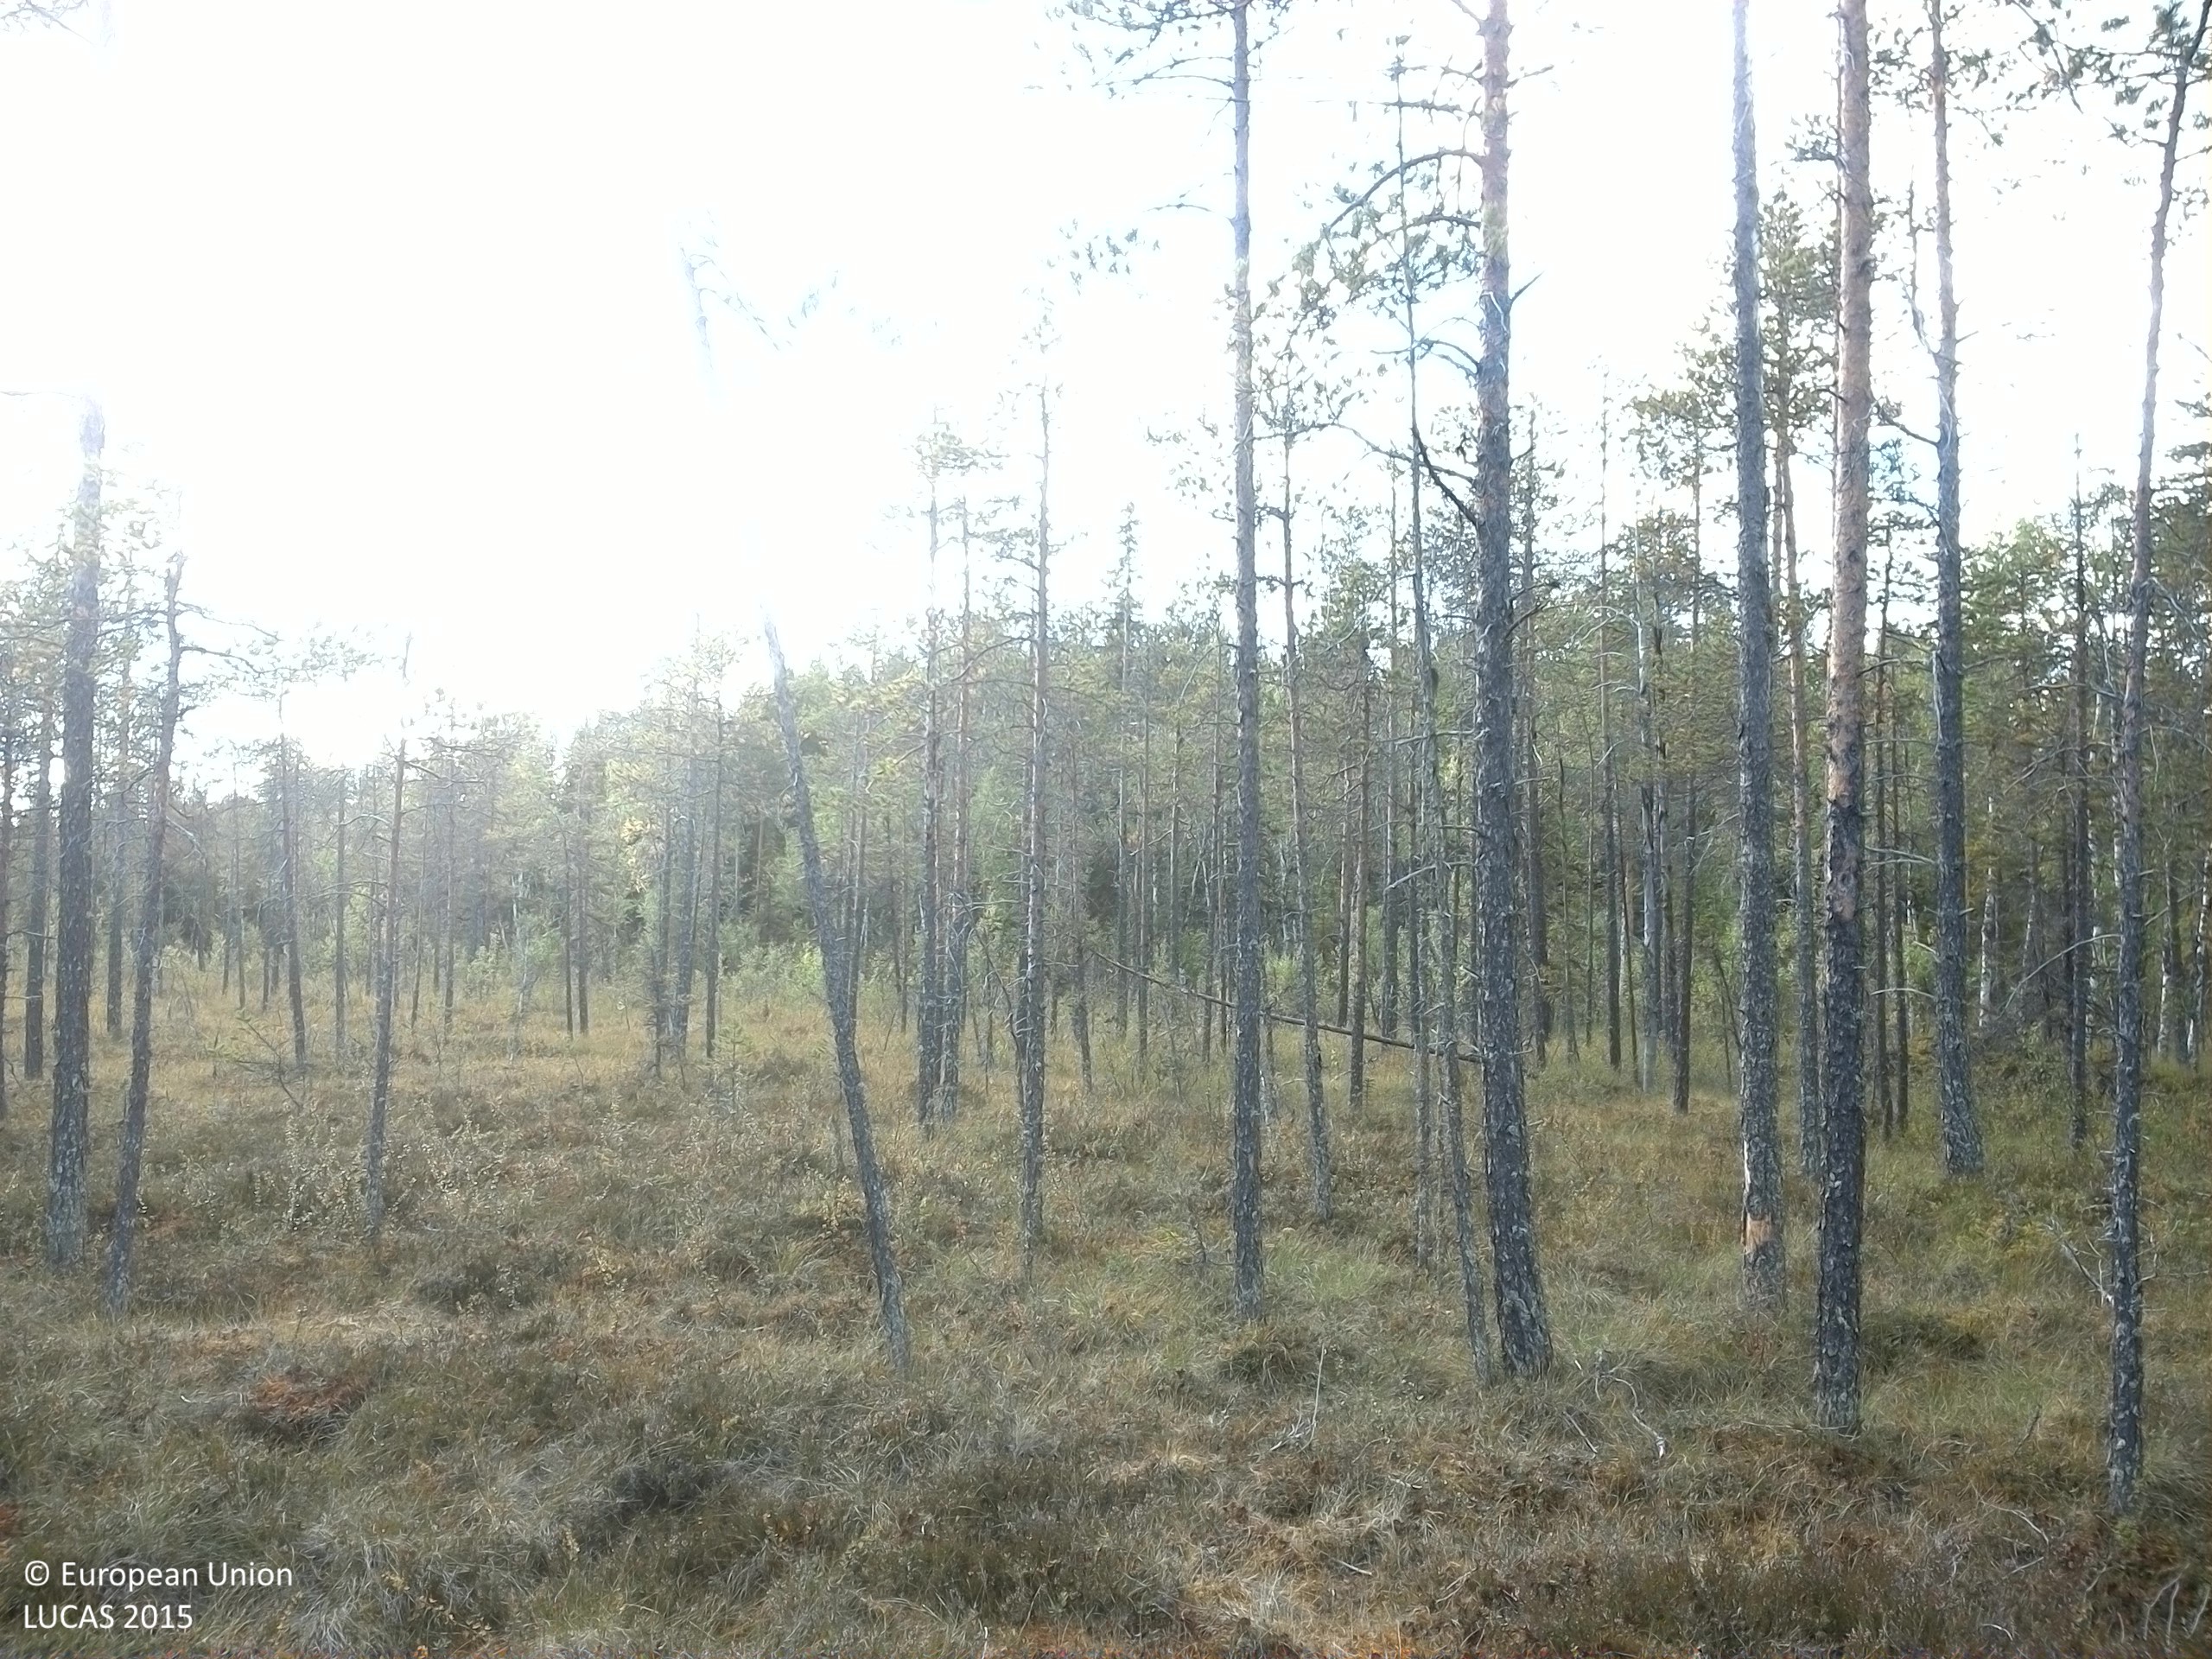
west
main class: Woodland
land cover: Pine dominated coniferous woodland
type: boreal forest
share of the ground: 10 - 25 %
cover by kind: lichens and mosses 35 %, shrubs 25 %, herbaceous plants 25 %, coniferous forest trees 15 %
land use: Semi-natural and natural areas not in use
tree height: < 5 m
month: August
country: SE
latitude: 64.0438
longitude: 17.4038
